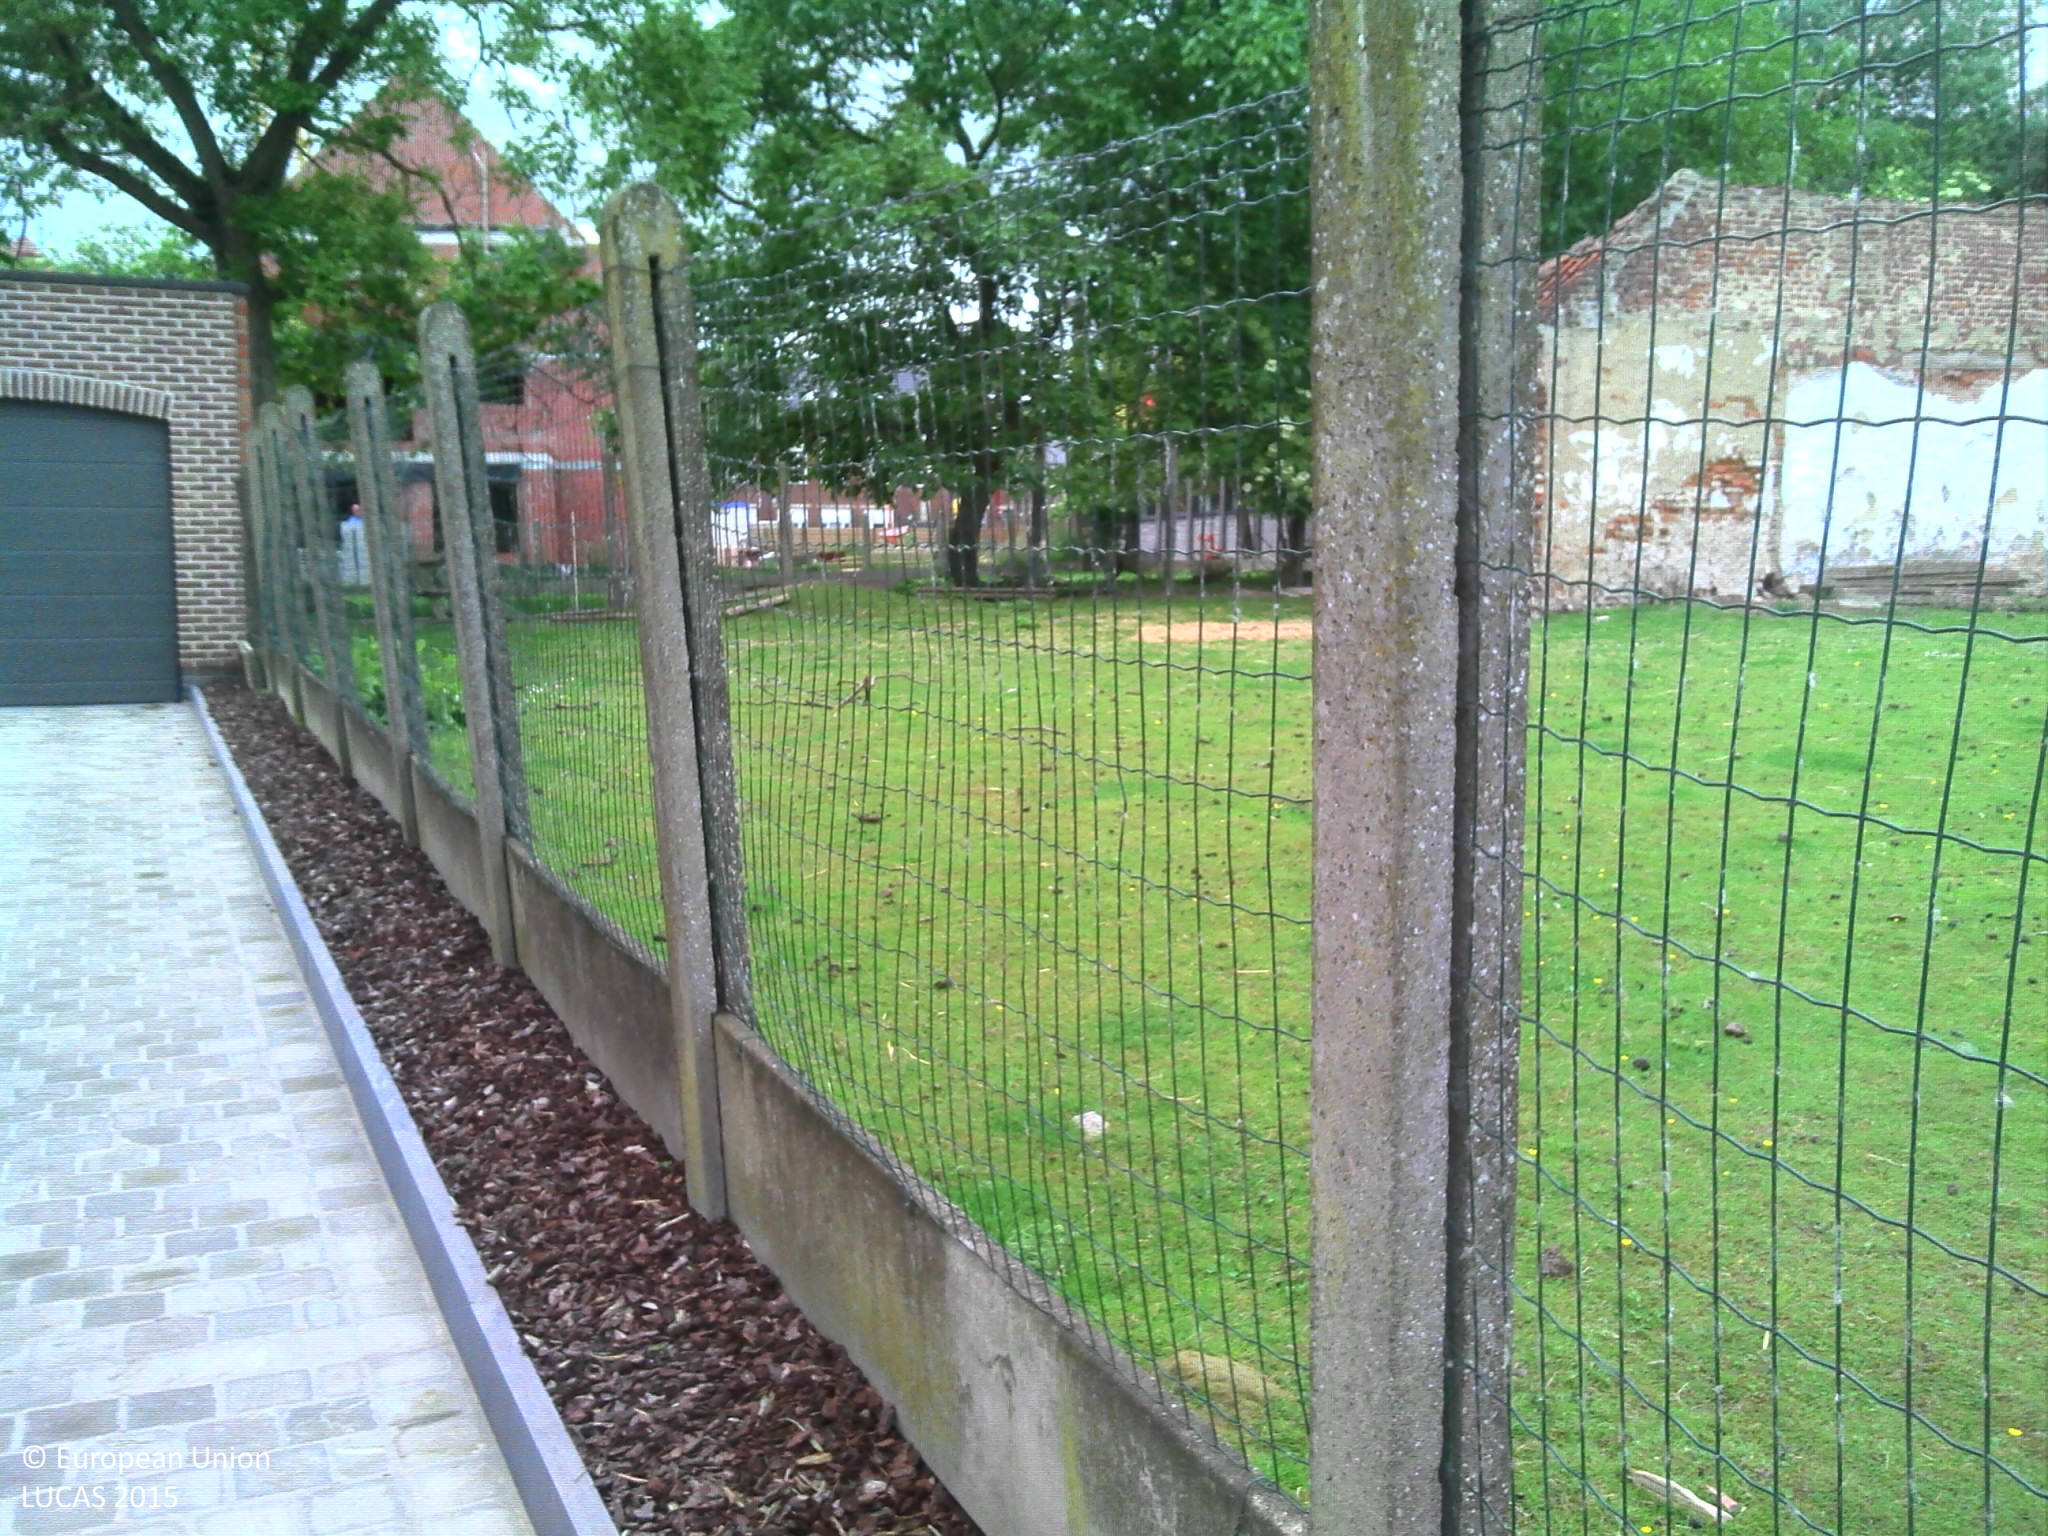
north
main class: Grassland
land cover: Grassland with sparse tree/shrub cover
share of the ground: > 75 %
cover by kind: herbaceous plants 95 %, broadleaved forest trees 5 %
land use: Residential
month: June
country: BE
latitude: 50.9042
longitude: 3.8932
